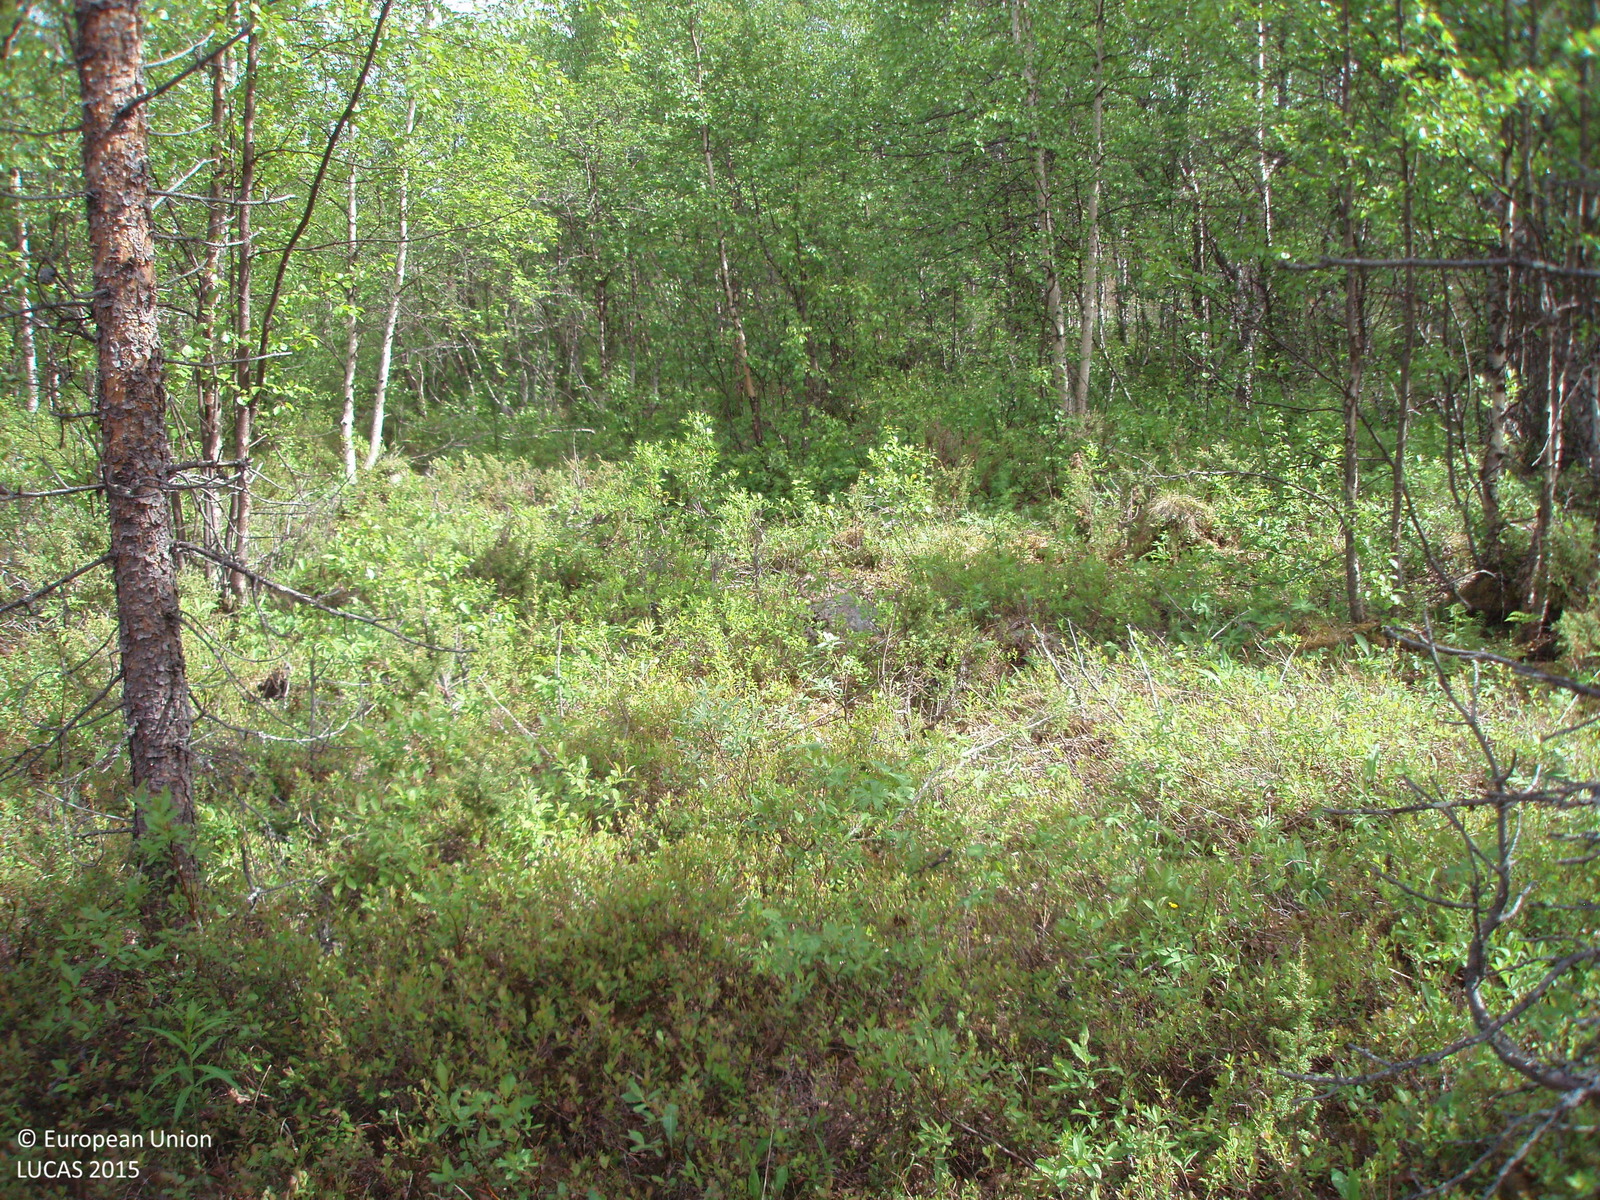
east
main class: Woodland
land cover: Pine dominated mixed woodland
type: boreal forest
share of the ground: > 75 %
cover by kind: coniferous forest trees 40 %, broadleaved forest trees 35 %, shrubs 25 %
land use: Forestry
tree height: > 5 m
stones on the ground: > 50 %
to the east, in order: Pine dominated mixed woodland; Broadleaved woodland; Rivers and streams; Broadleaved woodland; Rocks and stones; Pine dominated coniferous woodland; Shrubland with sparse tree cover
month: July
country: FI
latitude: 68.9083
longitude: 25.7938
